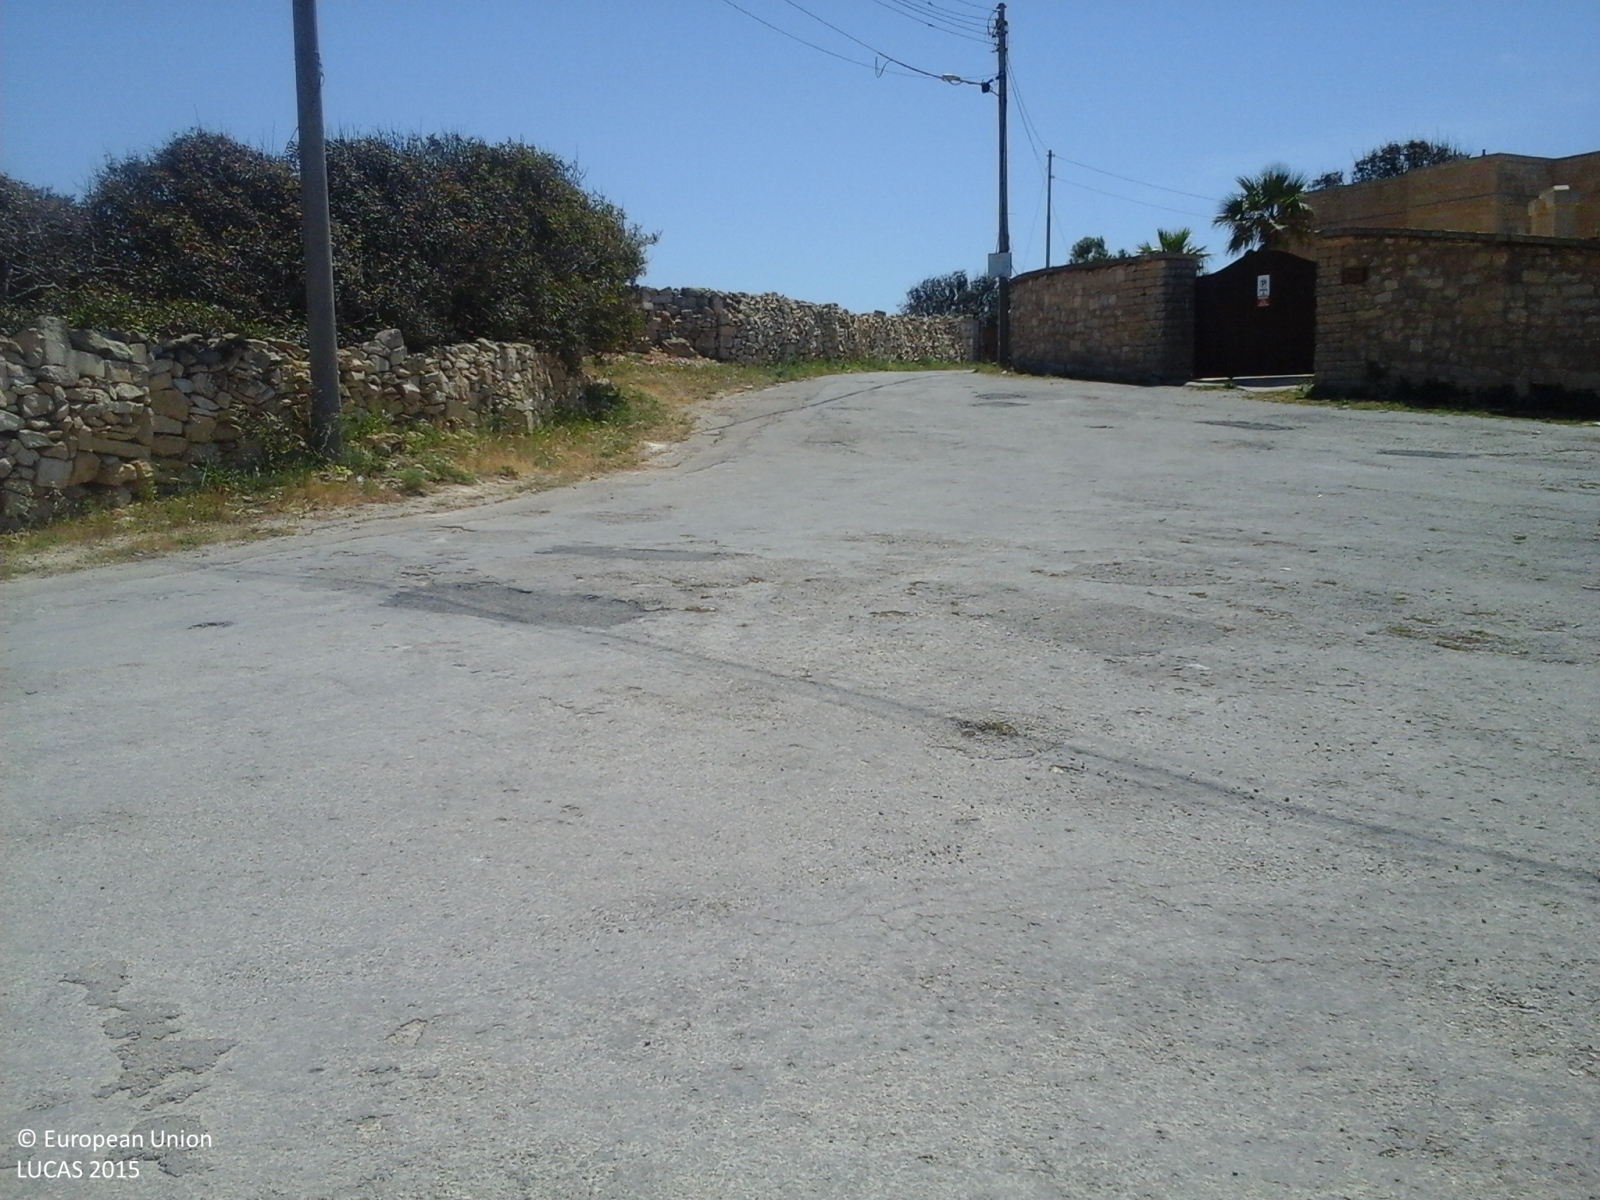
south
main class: Grassland
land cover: Spontaneously vegetated surfaces
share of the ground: 25 - 50 %
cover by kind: herbaceous plants 40 %, shrubs 5 %
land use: Agriculture (excluding fallow land and kitchen gardens)
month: May
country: MT
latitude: 35.8229
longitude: 14.4633
